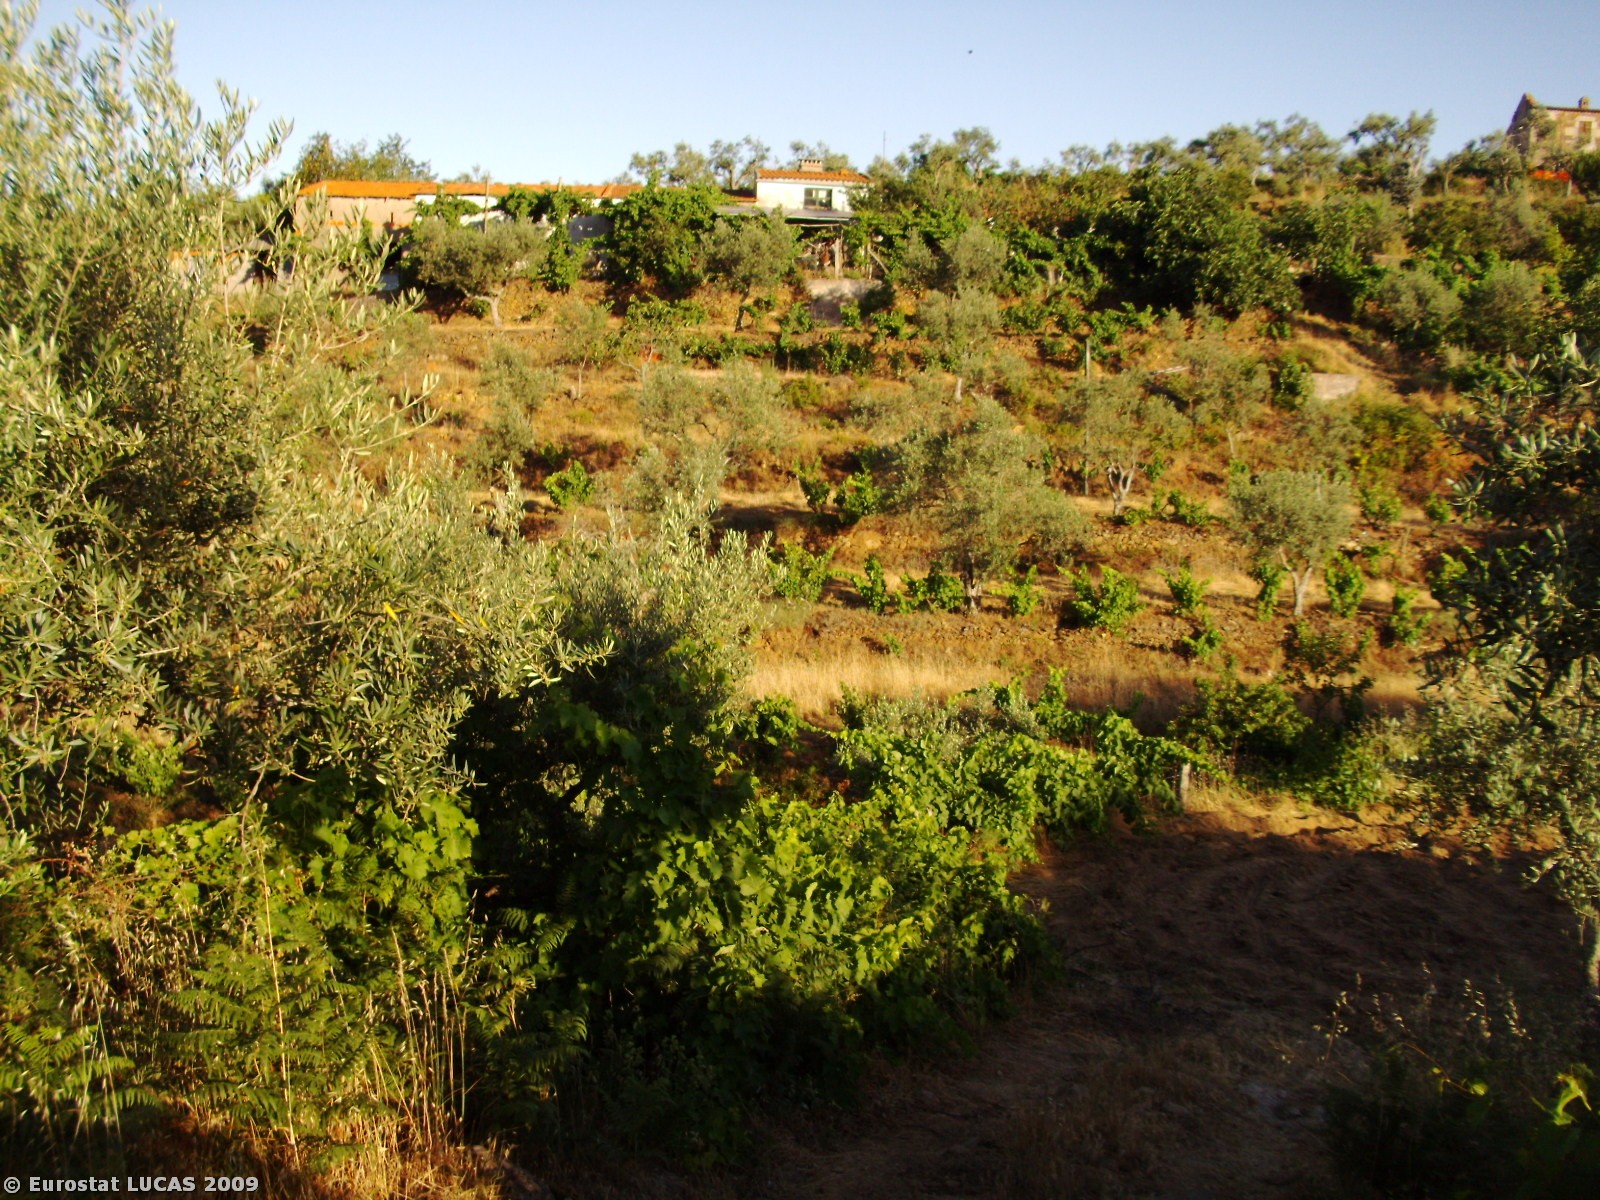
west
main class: Cropland
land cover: Olive groves
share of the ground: 50 - 75 %
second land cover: Vineyards
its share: 10 - 25 %
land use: Agriculture (excluding fallow land and kitchen gardens)
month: June
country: PT
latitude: 40.0366
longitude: -7.5547
